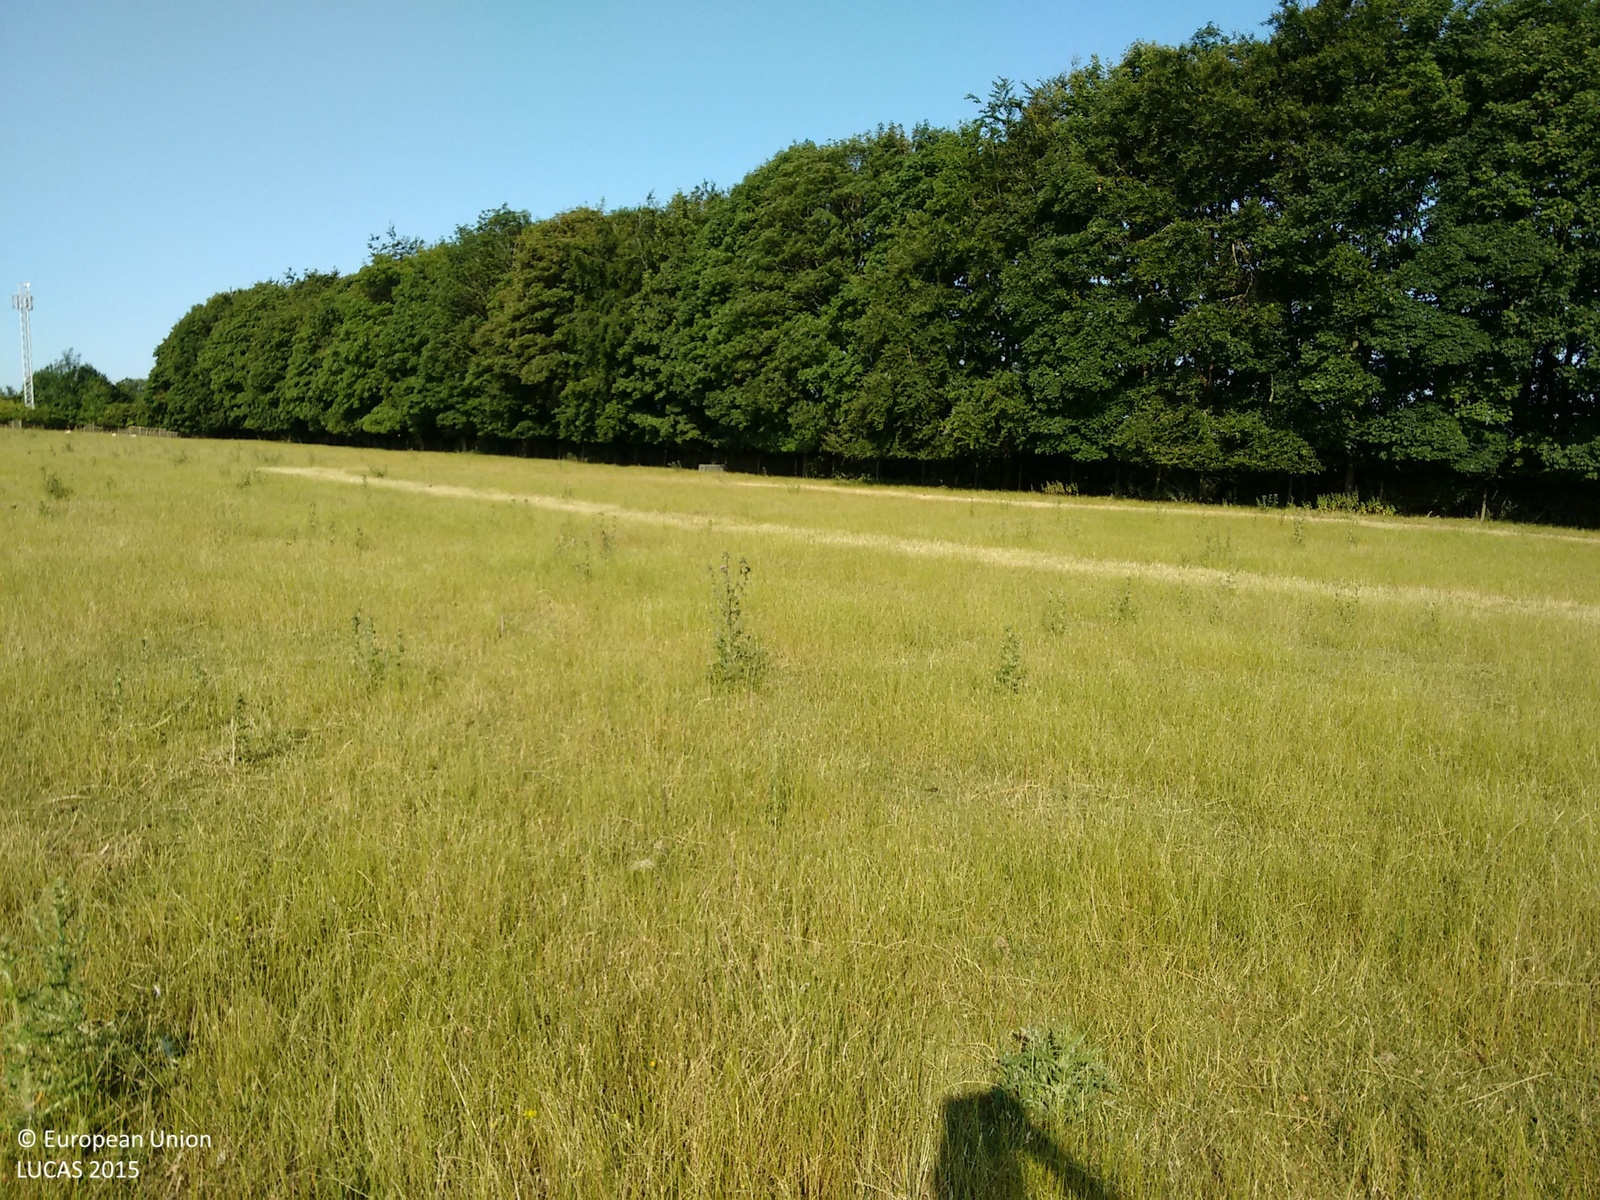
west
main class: Grassland
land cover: Grassland without tree/shrub cover
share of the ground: > 75 %
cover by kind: herbaceous plants 100 %
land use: Agriculture (excluding fallow land and kitchen gardens)
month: July
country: GB
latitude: 51.9688
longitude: -1.2409
